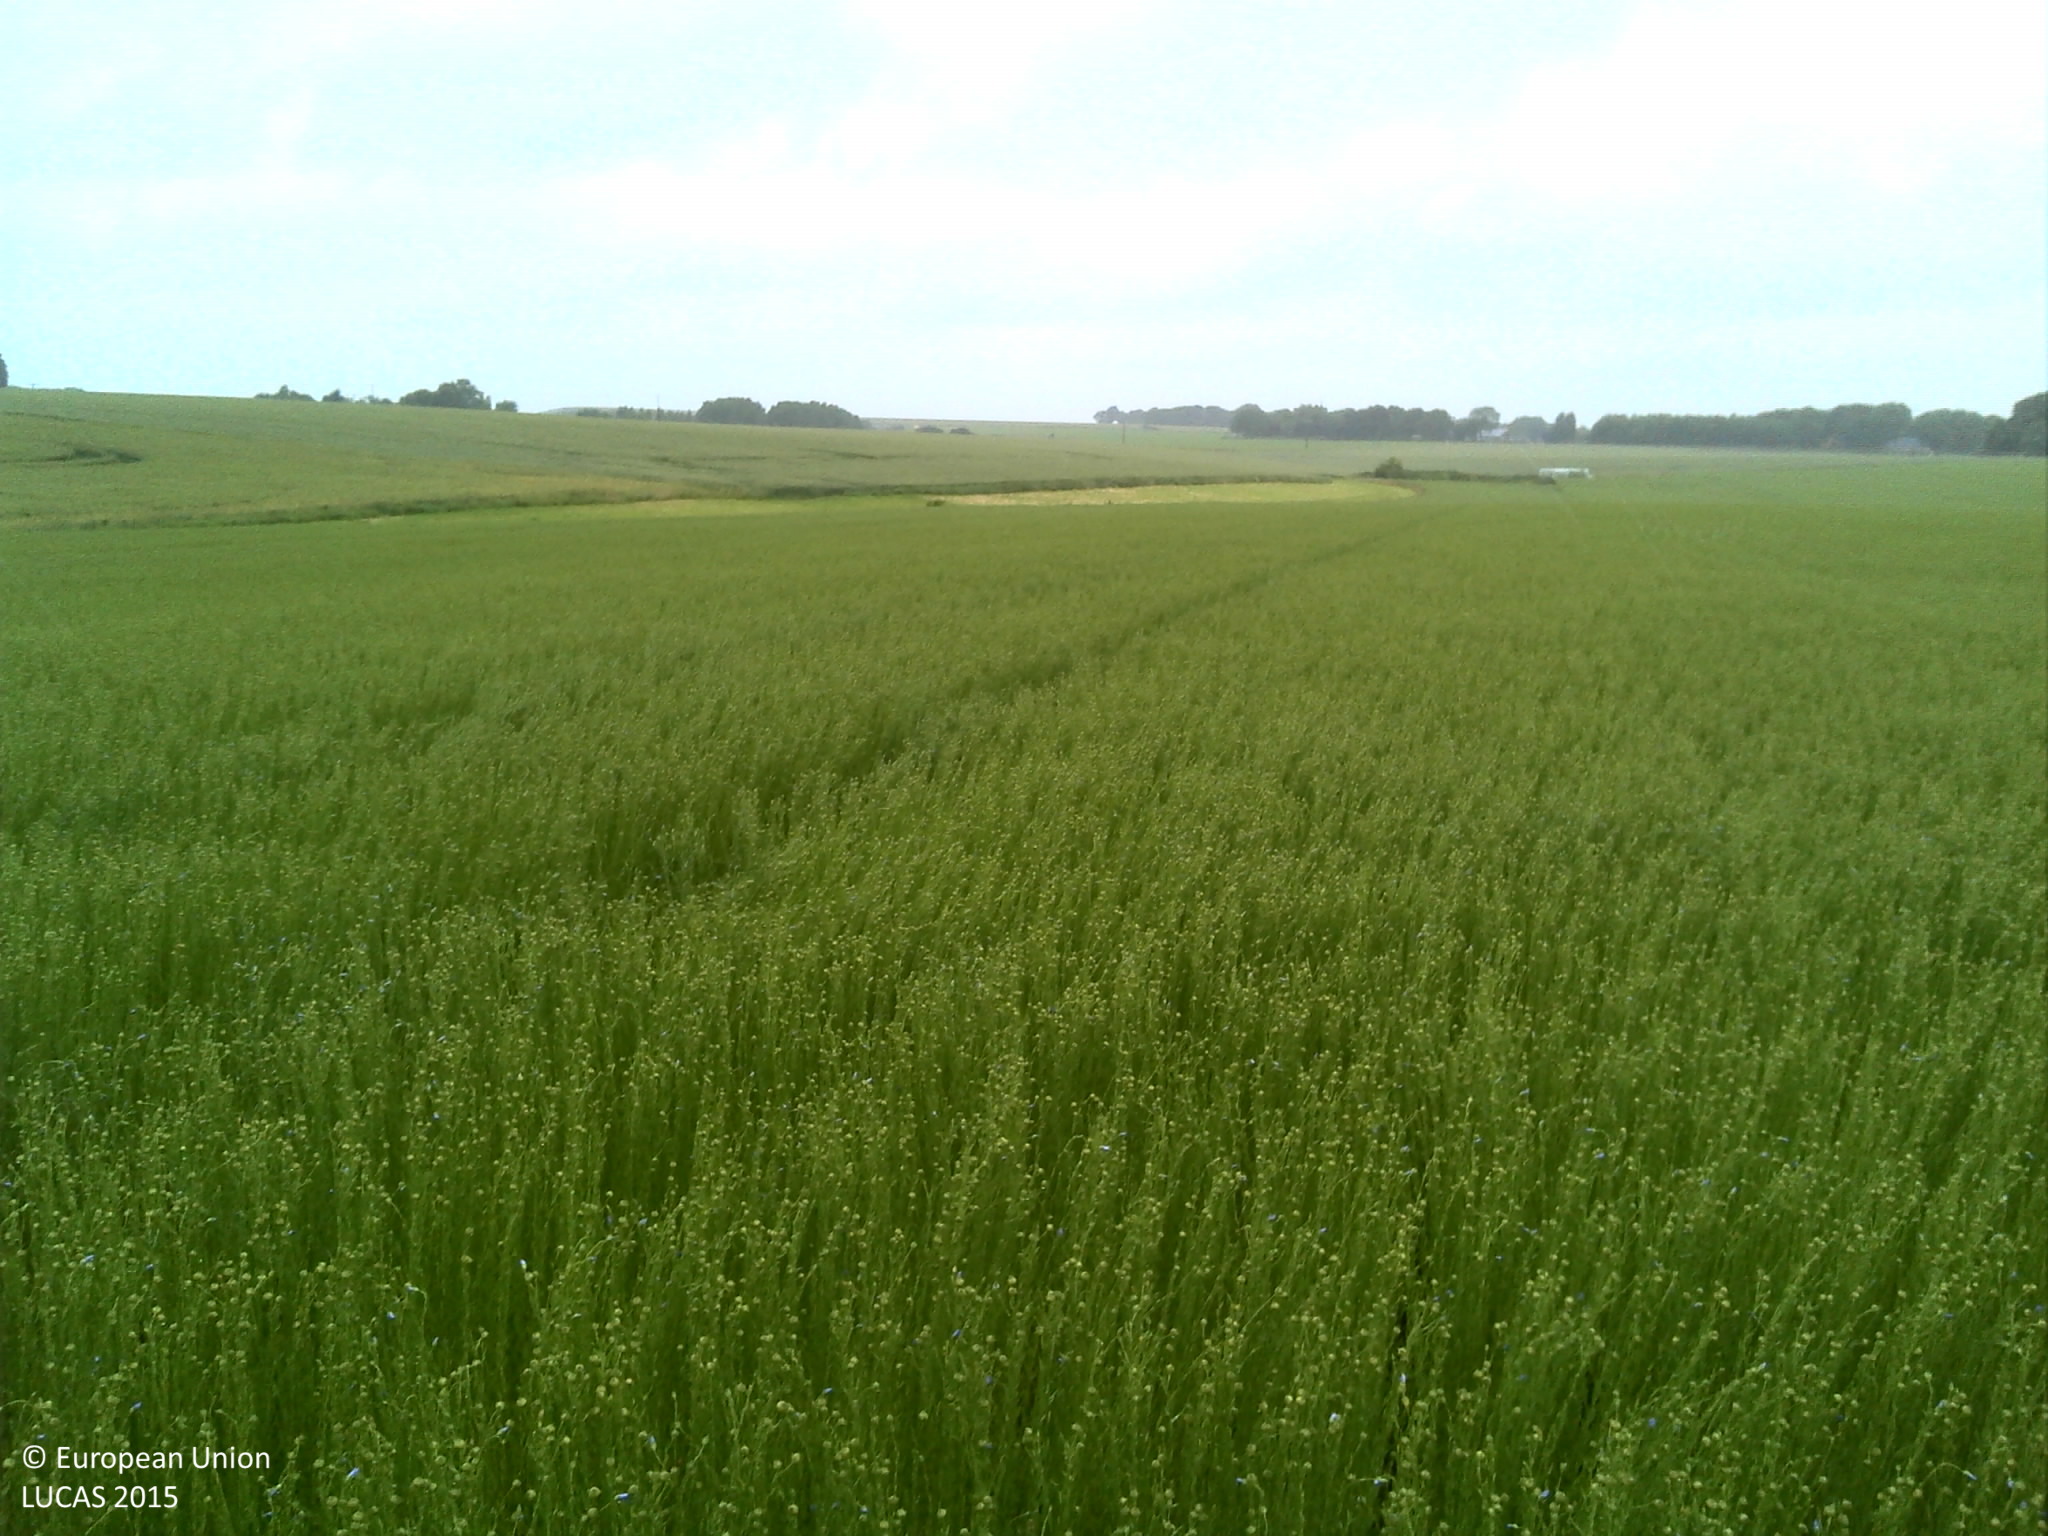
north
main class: Cropland
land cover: Other fibre and oleaginous crops
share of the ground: > 75 %
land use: Agriculture (excluding fallow land and kitchen gardens)
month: June
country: FR
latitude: 49.7134
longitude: 0.2768
